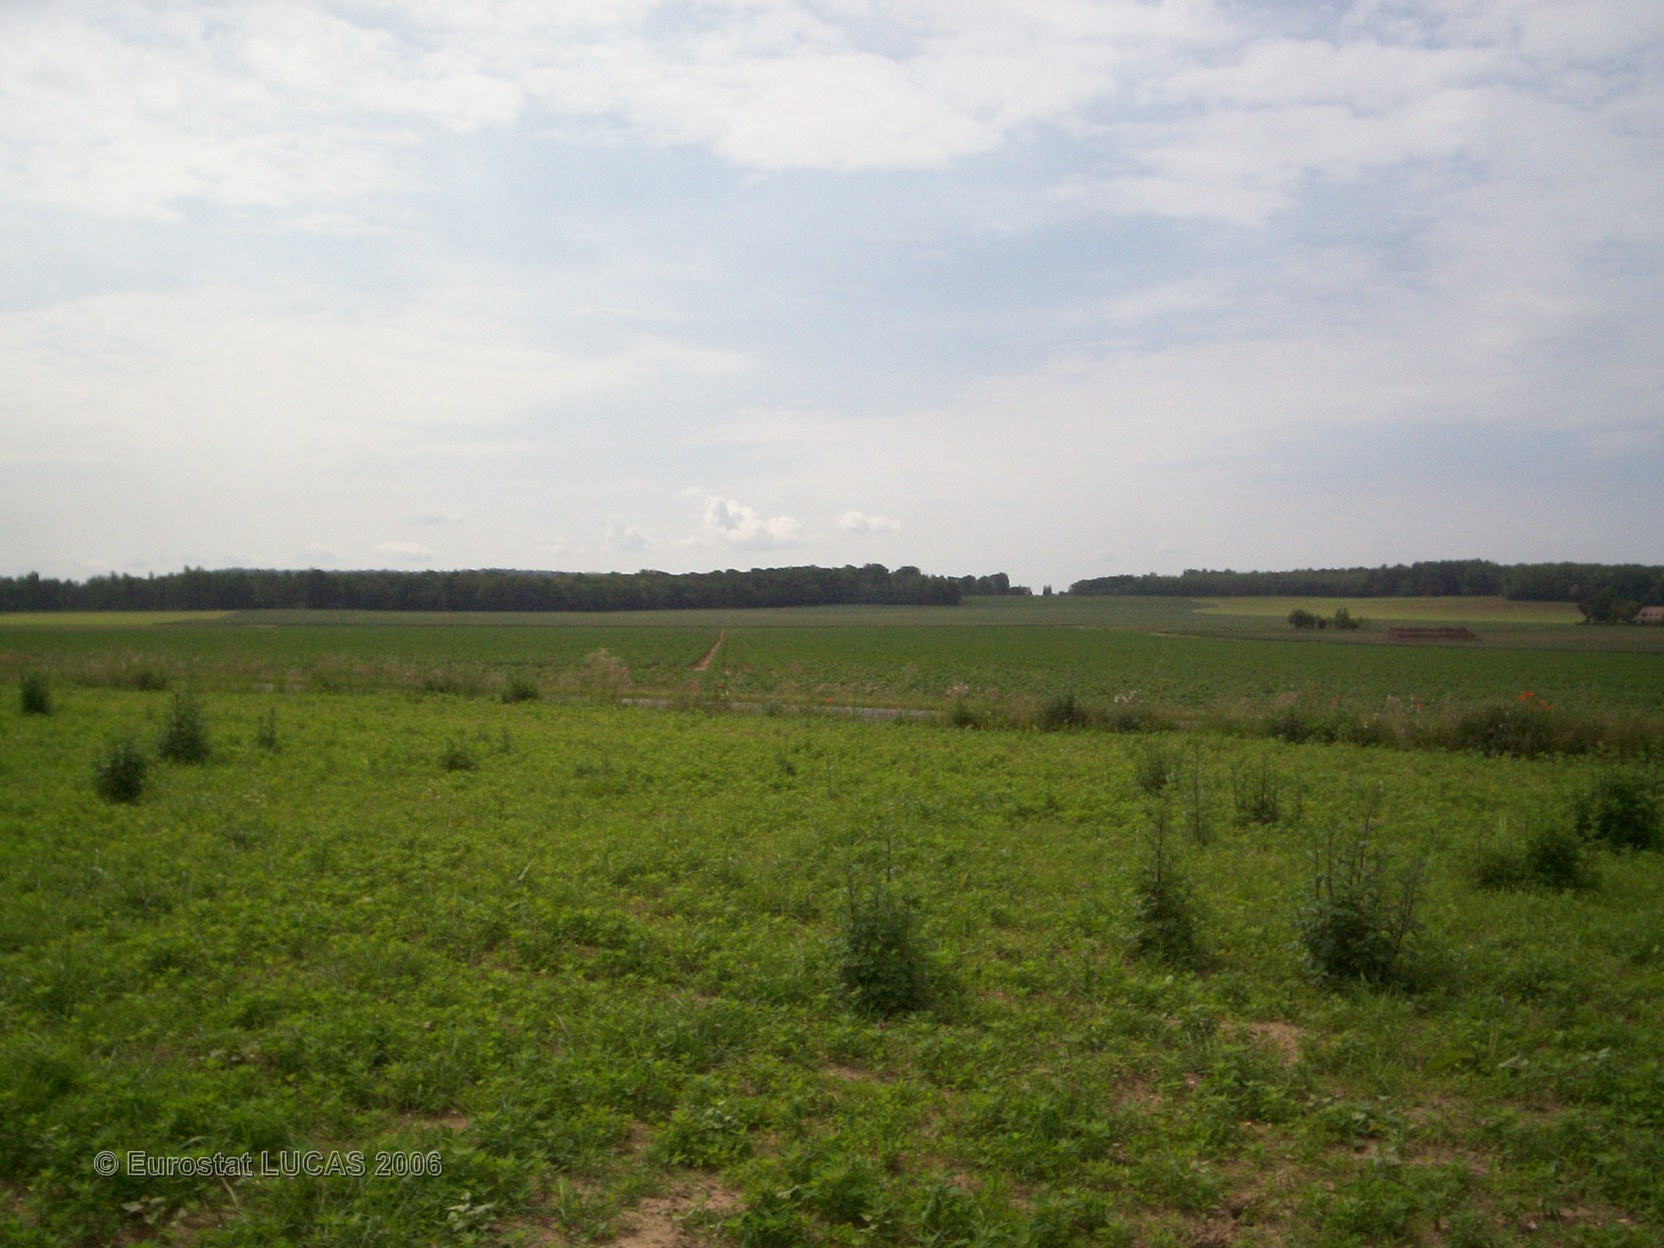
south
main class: Grassland
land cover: Grassland without tree/shrub cover
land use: Agriculture (excluding fallow land and kitchen gardens)
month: June
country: FR
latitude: 49.4279
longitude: 2.7232
